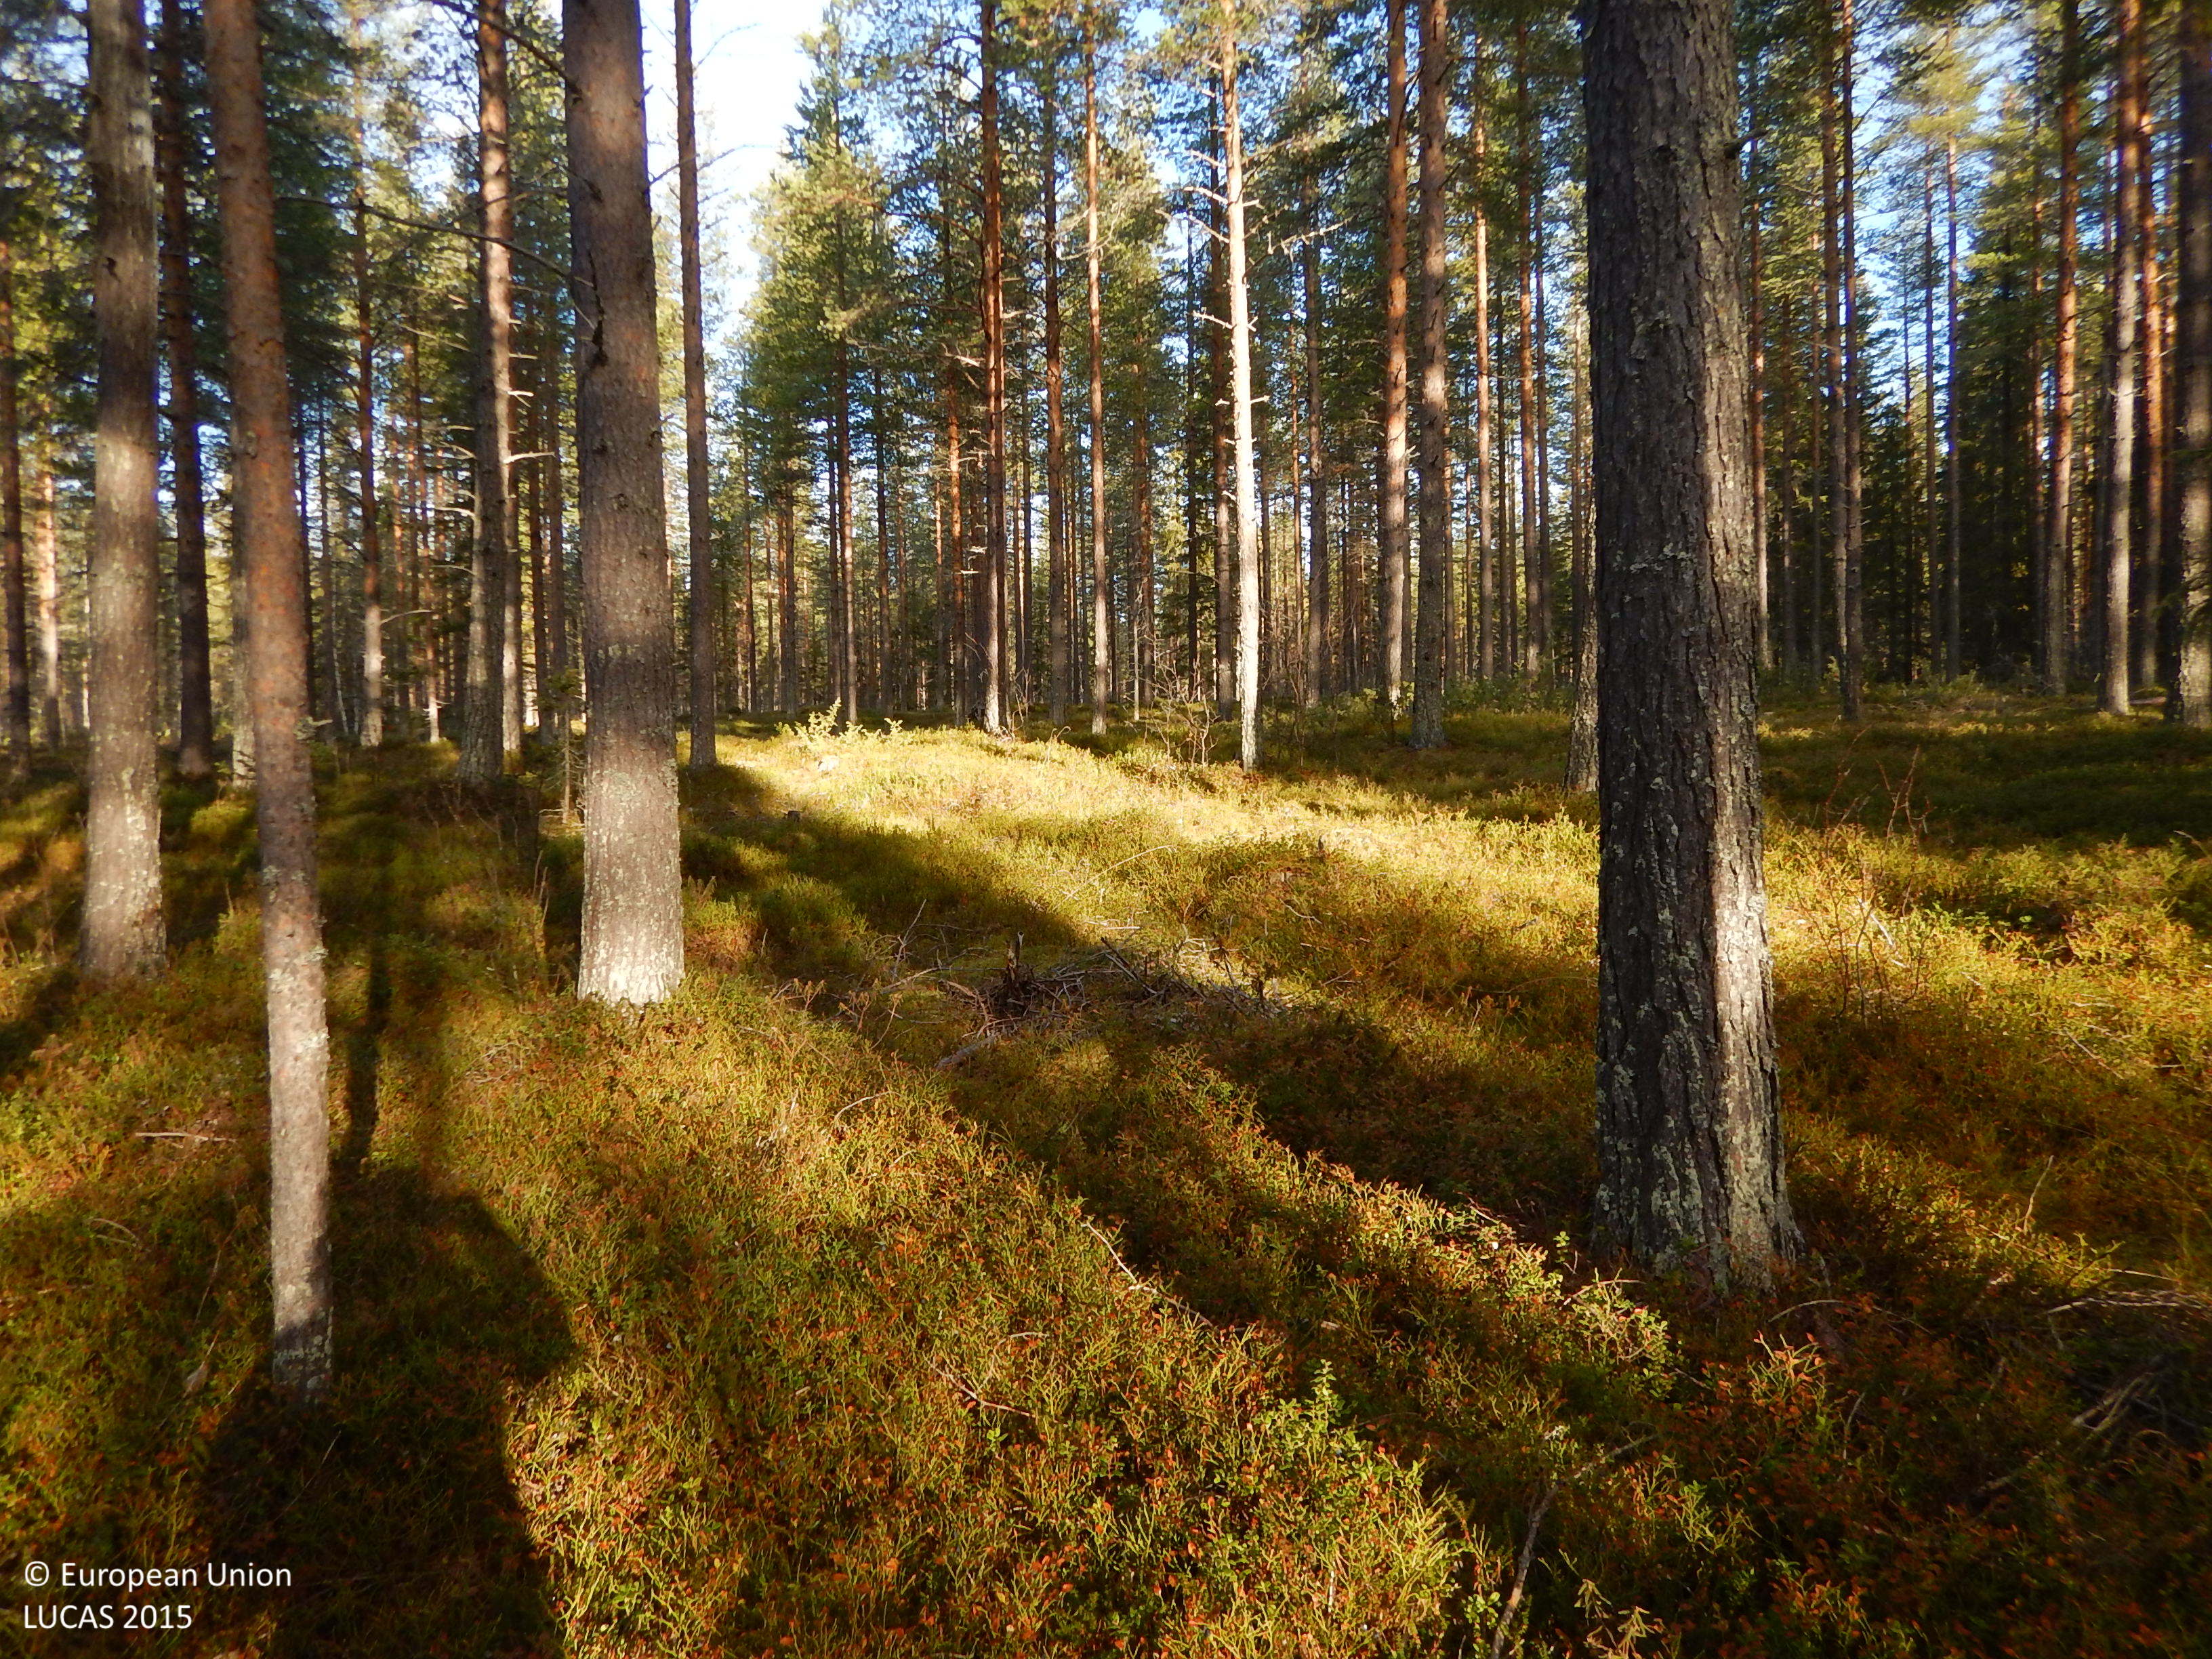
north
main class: Woodland
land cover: Pine dominated coniferous woodland
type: boreal forest
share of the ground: 50 - 75 %
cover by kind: coniferous forest trees 60 %, shrubs 20 %, herbaceous plants 10 %, lichens and mosses 10 %
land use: Forestry
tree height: > 5 m
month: October
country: SE
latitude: 65.0699
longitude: 20.2396
